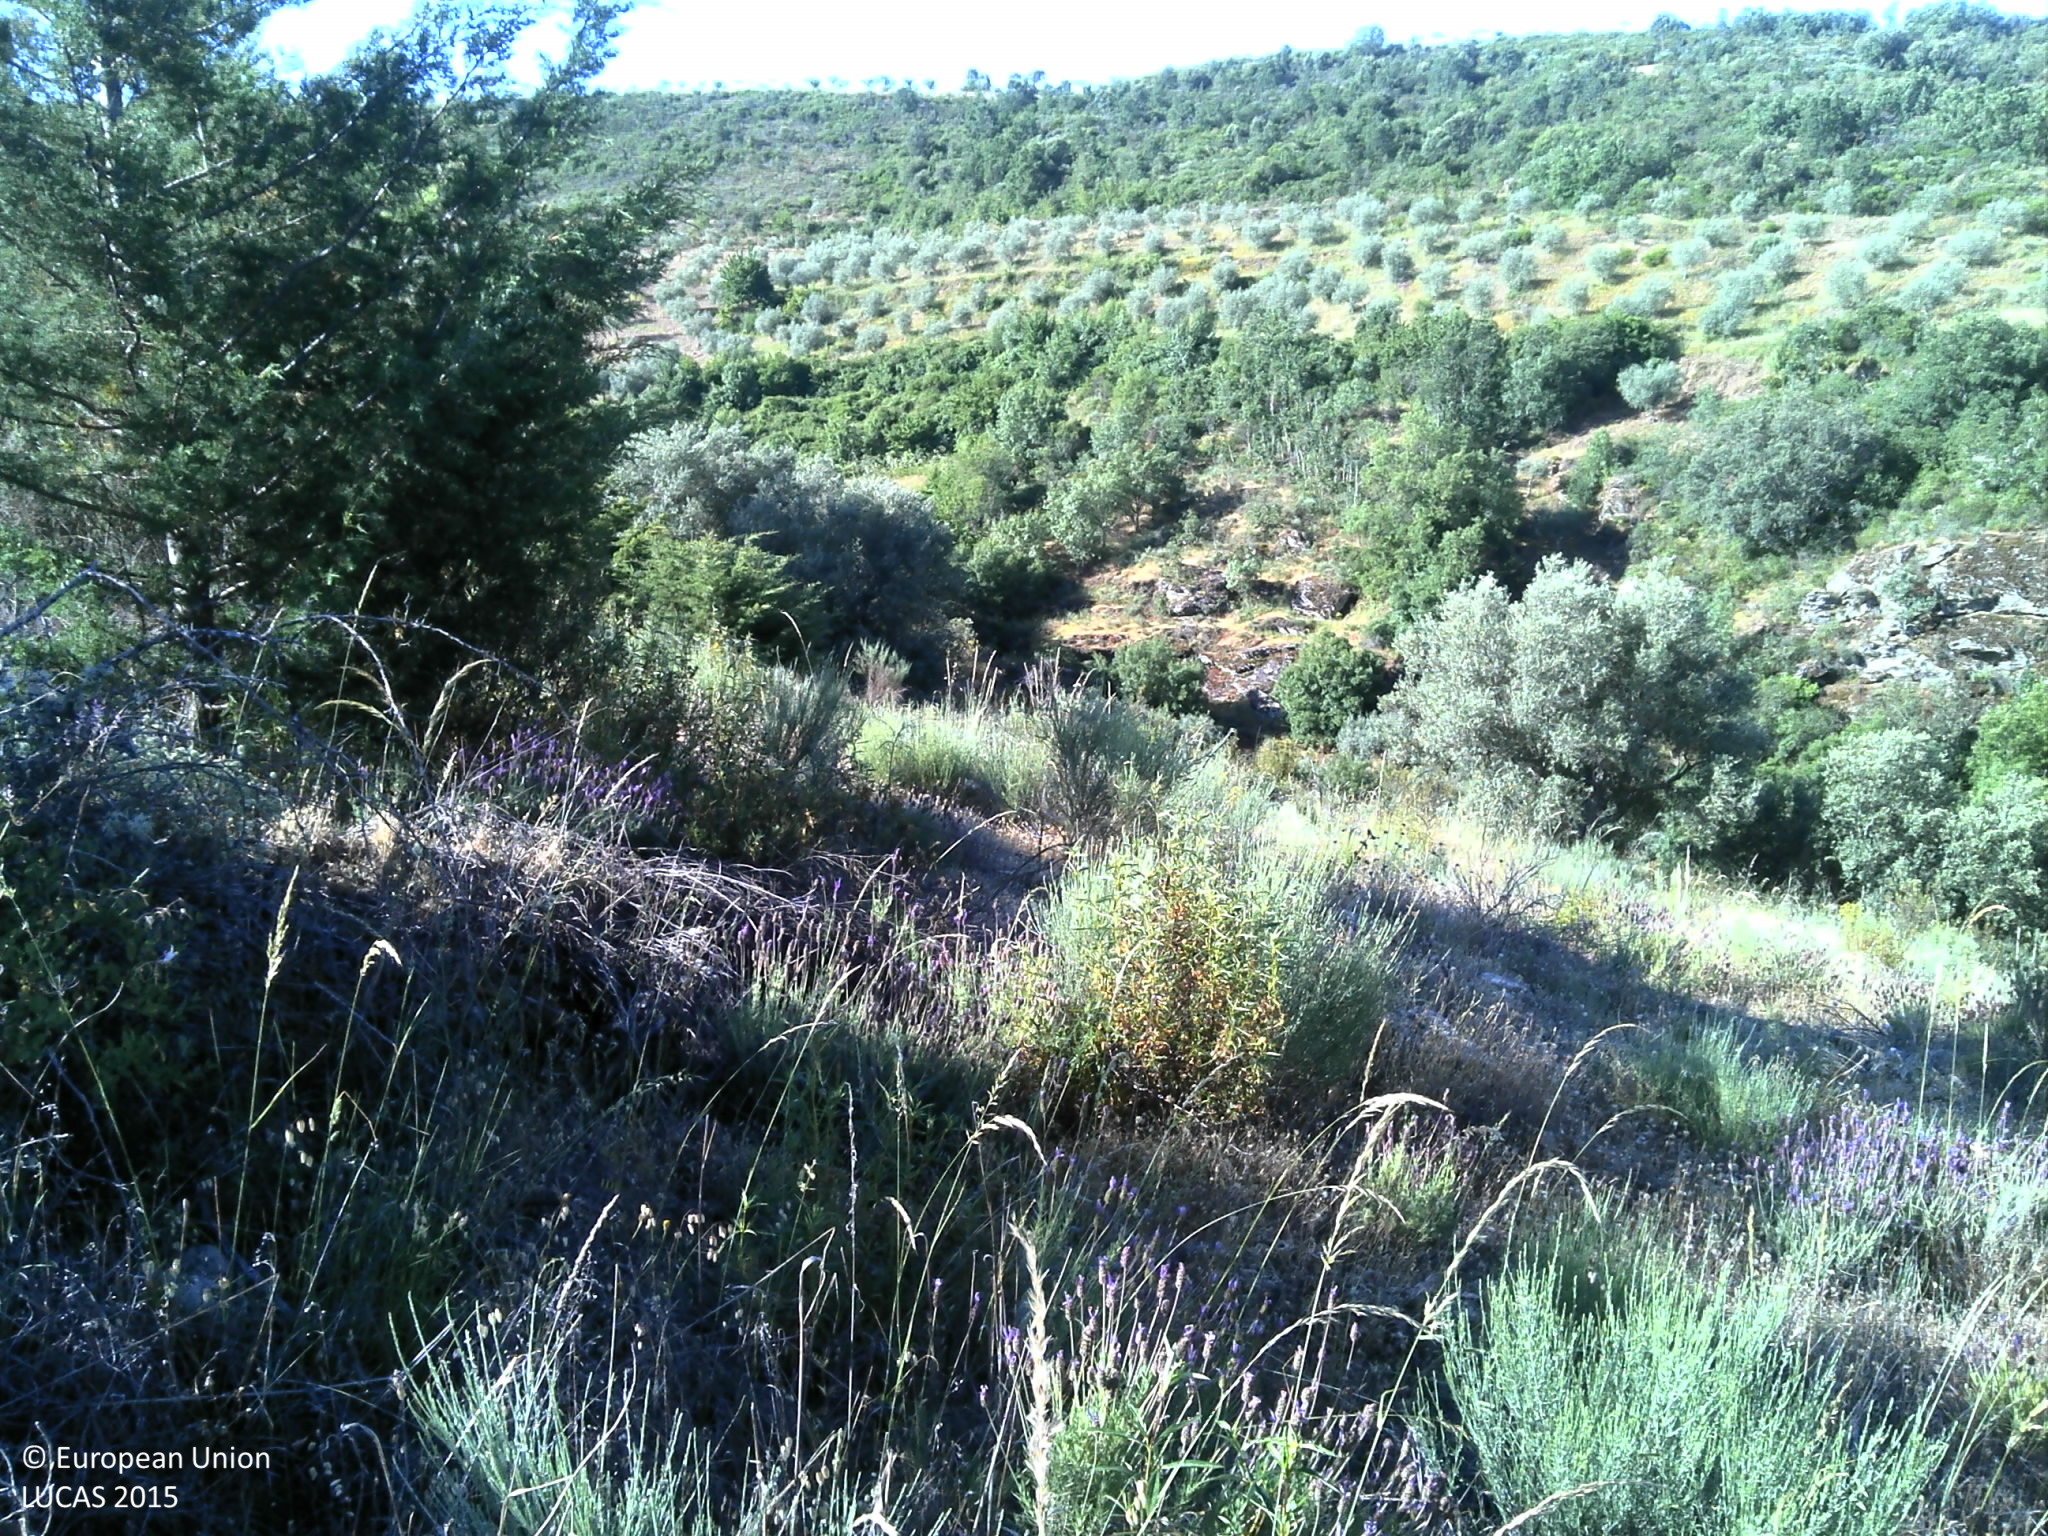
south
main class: Woodland
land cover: Other coniferous woodland
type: coniferous forest of the mediterranean region
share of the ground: 10 - 25 %
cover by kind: shrubs 70 %, coniferous forest trees 10 %, herbaceous plants 10 %, unconsolidated bare surface 10 %
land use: Forestry
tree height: < 5 m
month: May
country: PT
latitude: 41.5937
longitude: -6.5529
